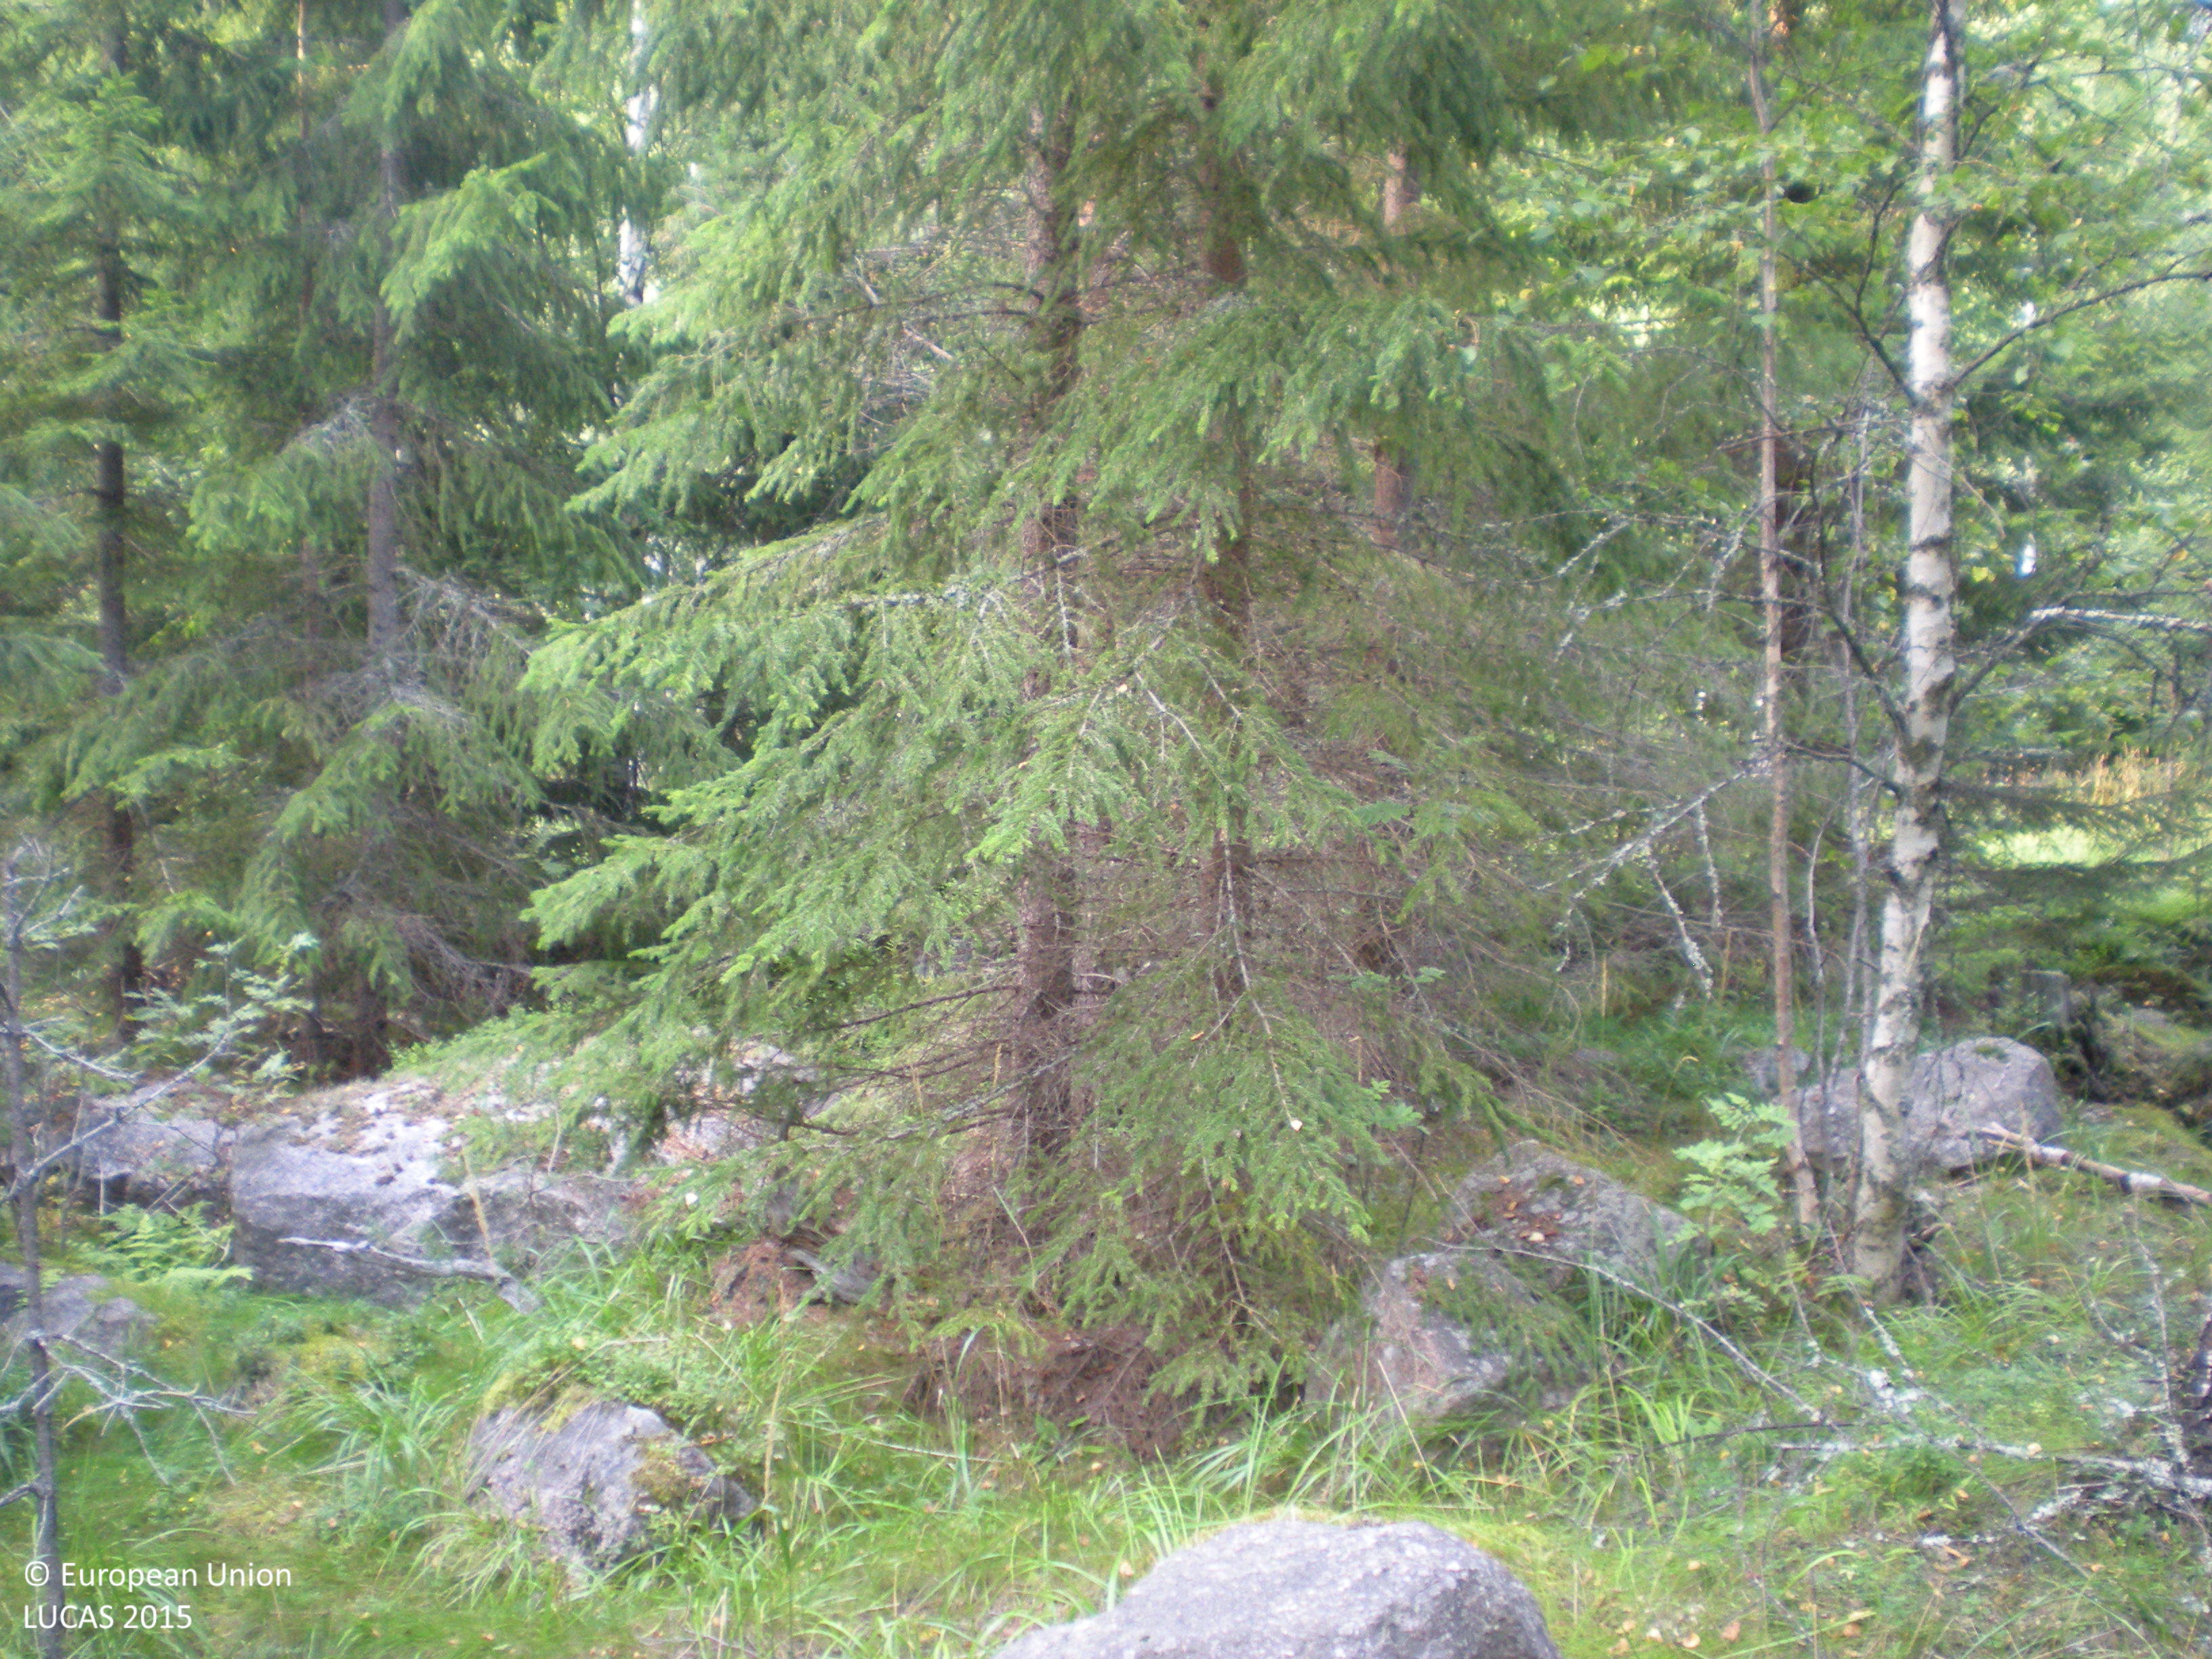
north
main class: Woodland
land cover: Spruce dominated coniferous woodland
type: boreal forest
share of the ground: 50 - 75 %
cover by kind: coniferous forest trees 65 %, herbaceous plants 15 %, broadleaved forest trees 5 %, shrubs 5 %, lichens and mosses 5 %, consolidated bare surface 5 %
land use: Forestry
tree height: > 5 m
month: August
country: SE
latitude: 60.4325
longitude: 17.1665
